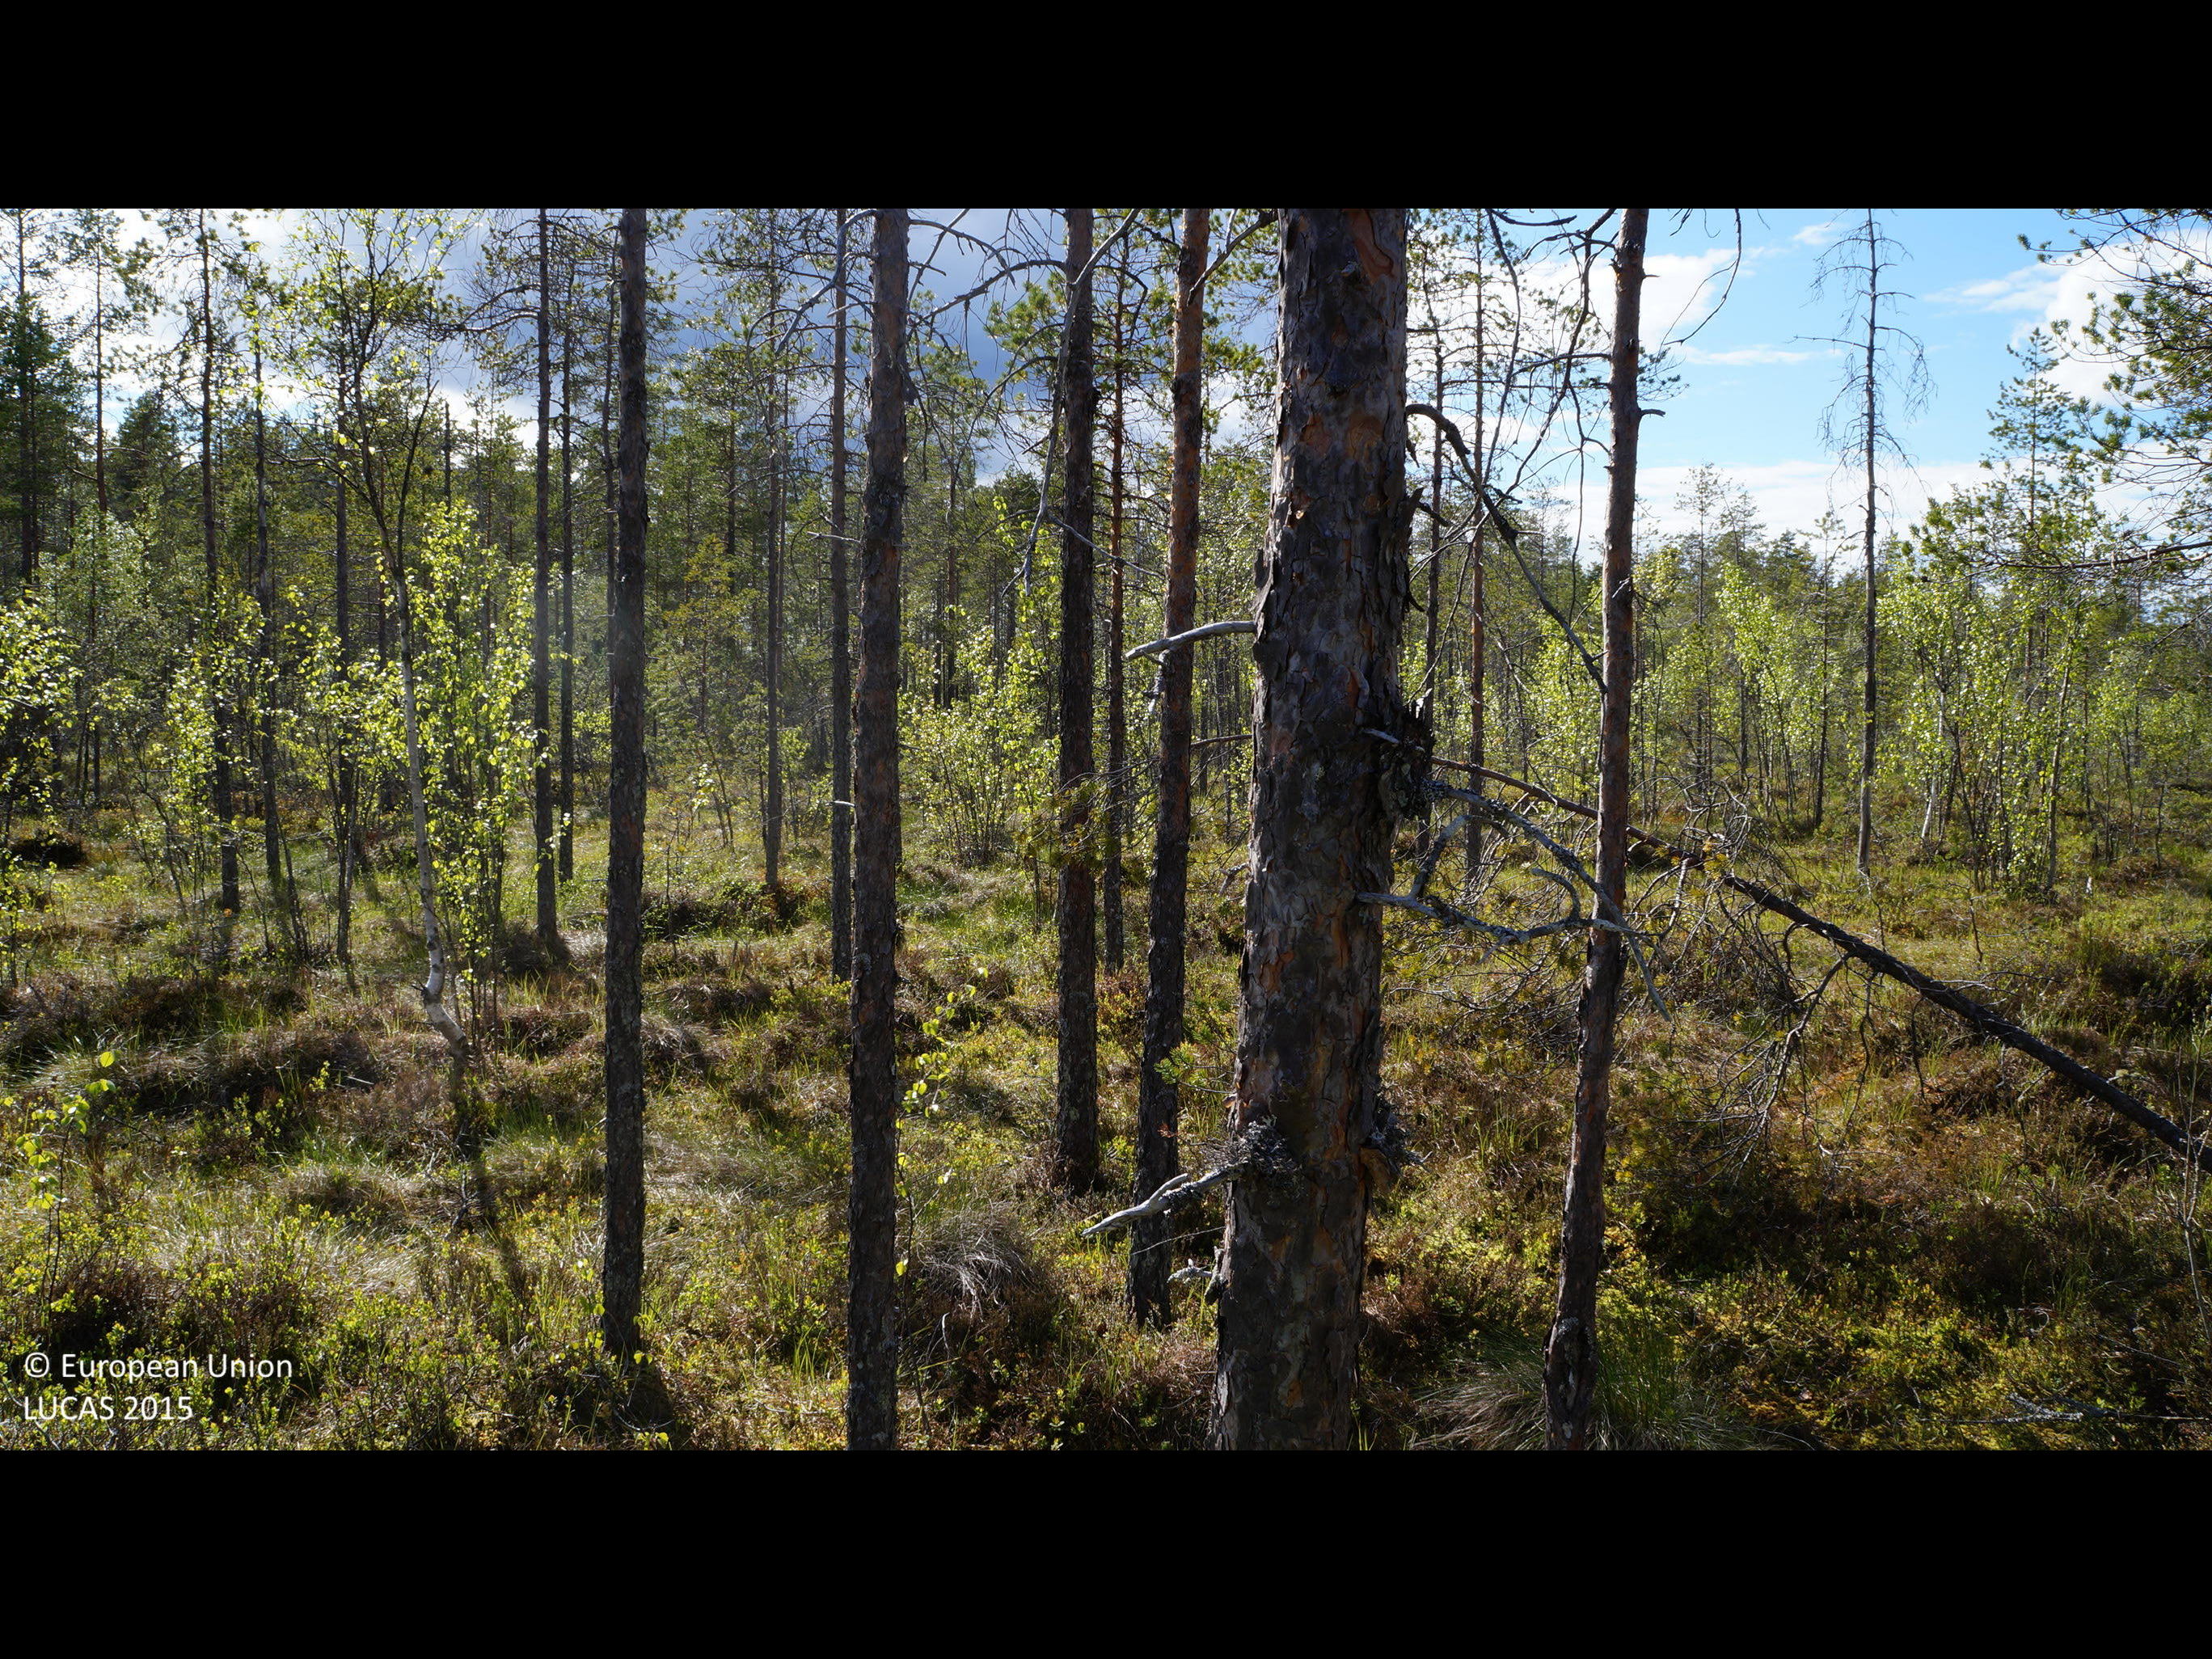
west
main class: Woodland
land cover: Pine dominated coniferous woodland
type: boreal forest
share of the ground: 50 - 75 %
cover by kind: coniferous forest trees 70 %, lichens and mosses 20 %, herbaceous plants 10 %
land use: Forestry
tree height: > 5 m
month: June
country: FI
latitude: 63.8015
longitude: 24.0979
